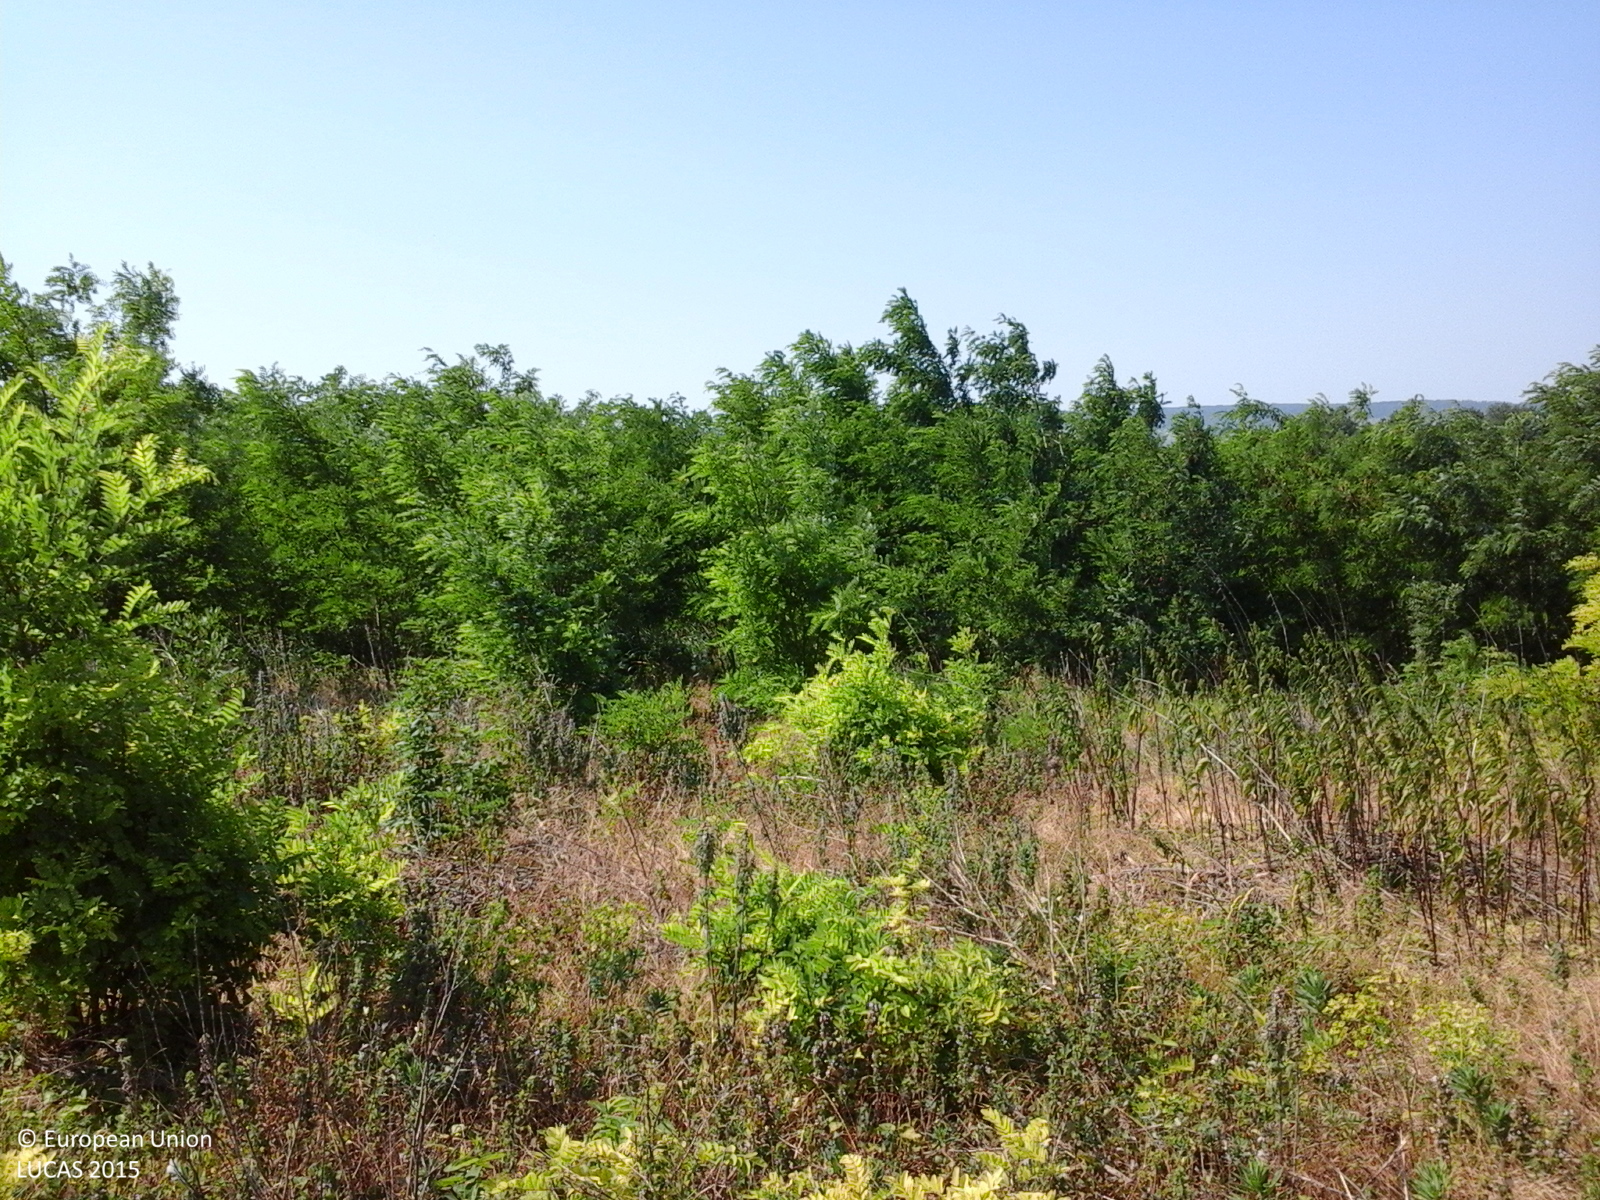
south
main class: Shrubland
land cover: Shrubland with sparse tree cover
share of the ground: > 75 %
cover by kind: shrubs 65 %, herbaceous plants 30 %, broadleaved forest trees 5 %
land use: Semi-natural and natural areas not in use
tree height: < 5 m
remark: Clear cut
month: June
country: RO
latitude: 46.9055
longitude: 28.0240
